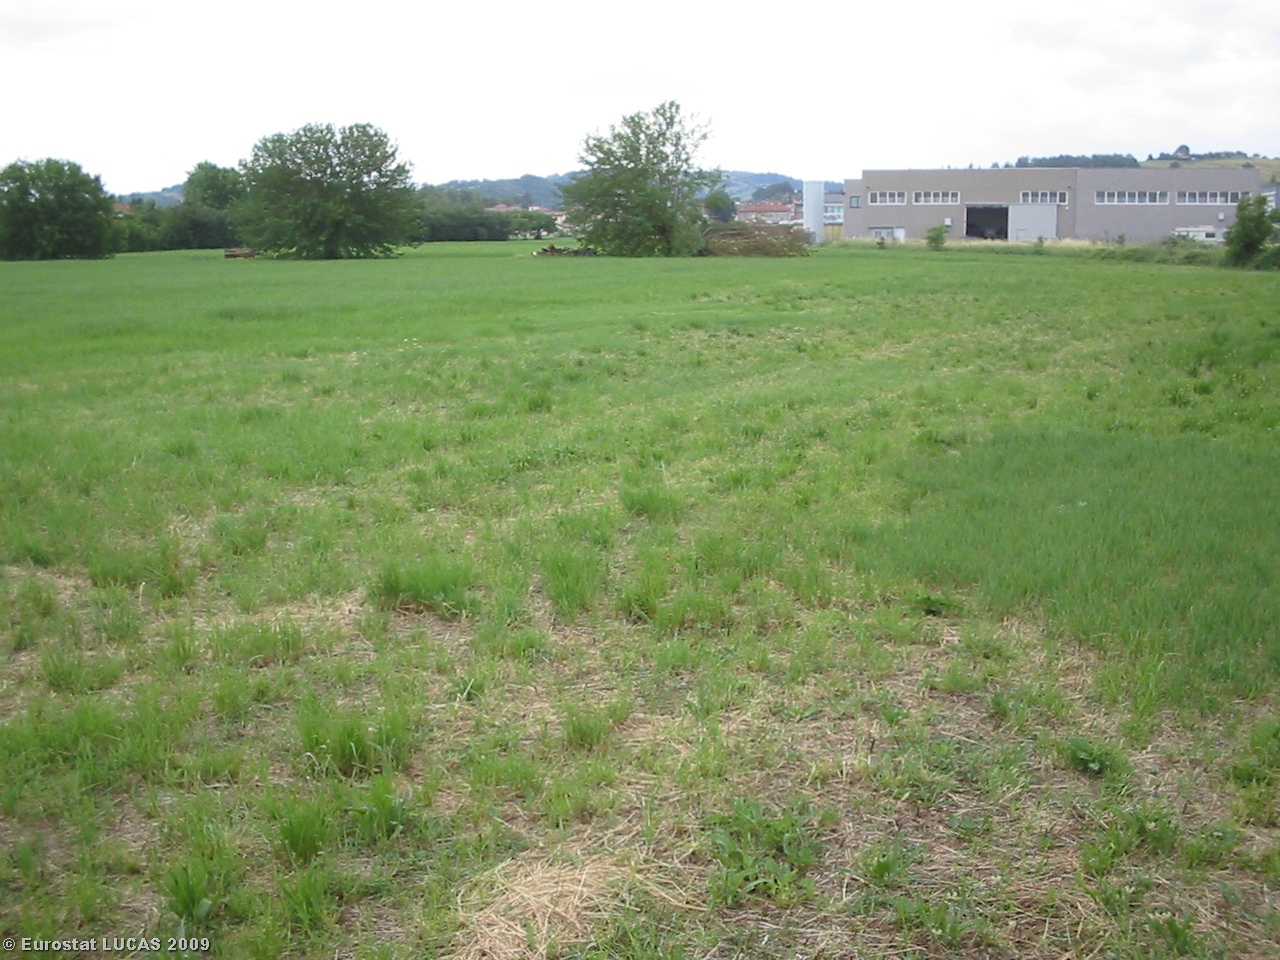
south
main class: Grassland
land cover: Grassland without tree/shrub cover
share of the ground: > 75 %
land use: Agriculture (excluding fallow land and kitchen gardens)
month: June
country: IT
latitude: 44.6929
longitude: 10.2644
